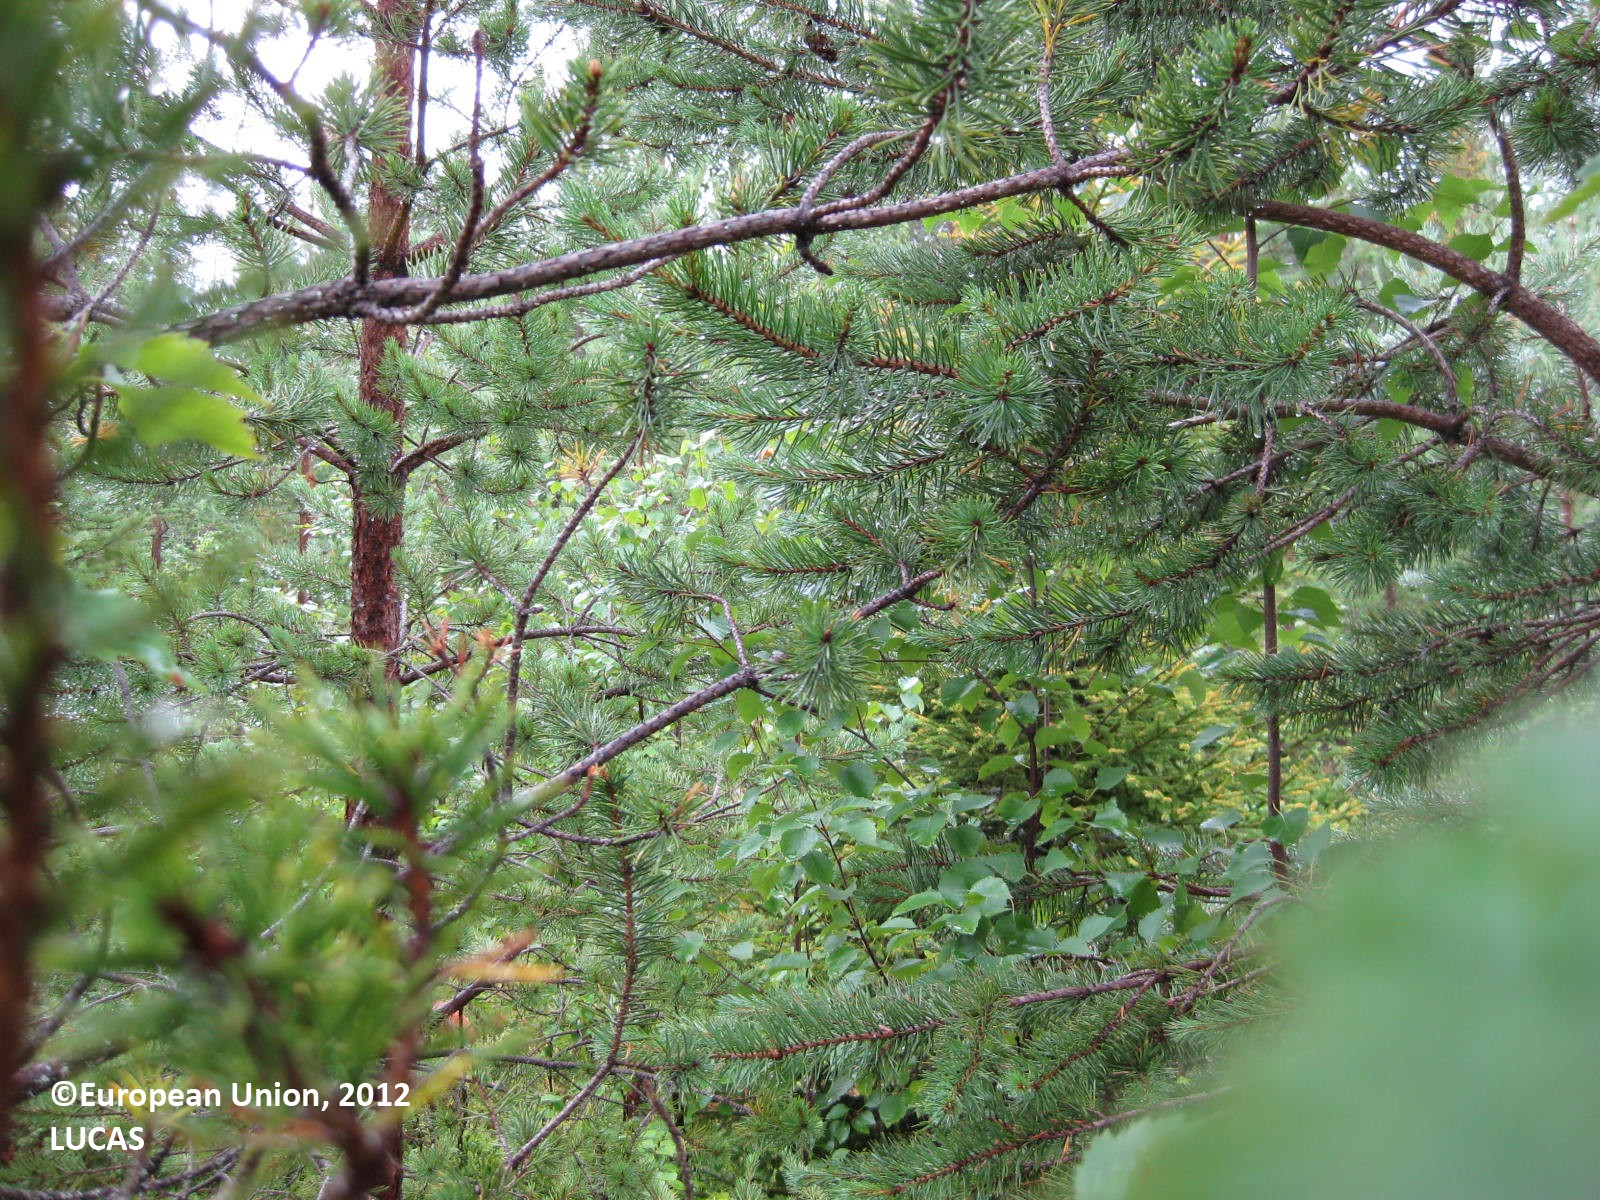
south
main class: Woodland
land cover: Pine dominated mixed woodland
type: boreal forest
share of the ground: > 75 %
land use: Forestry
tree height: > 5 m
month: August
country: FI
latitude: 66.0940
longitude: 28.2104
